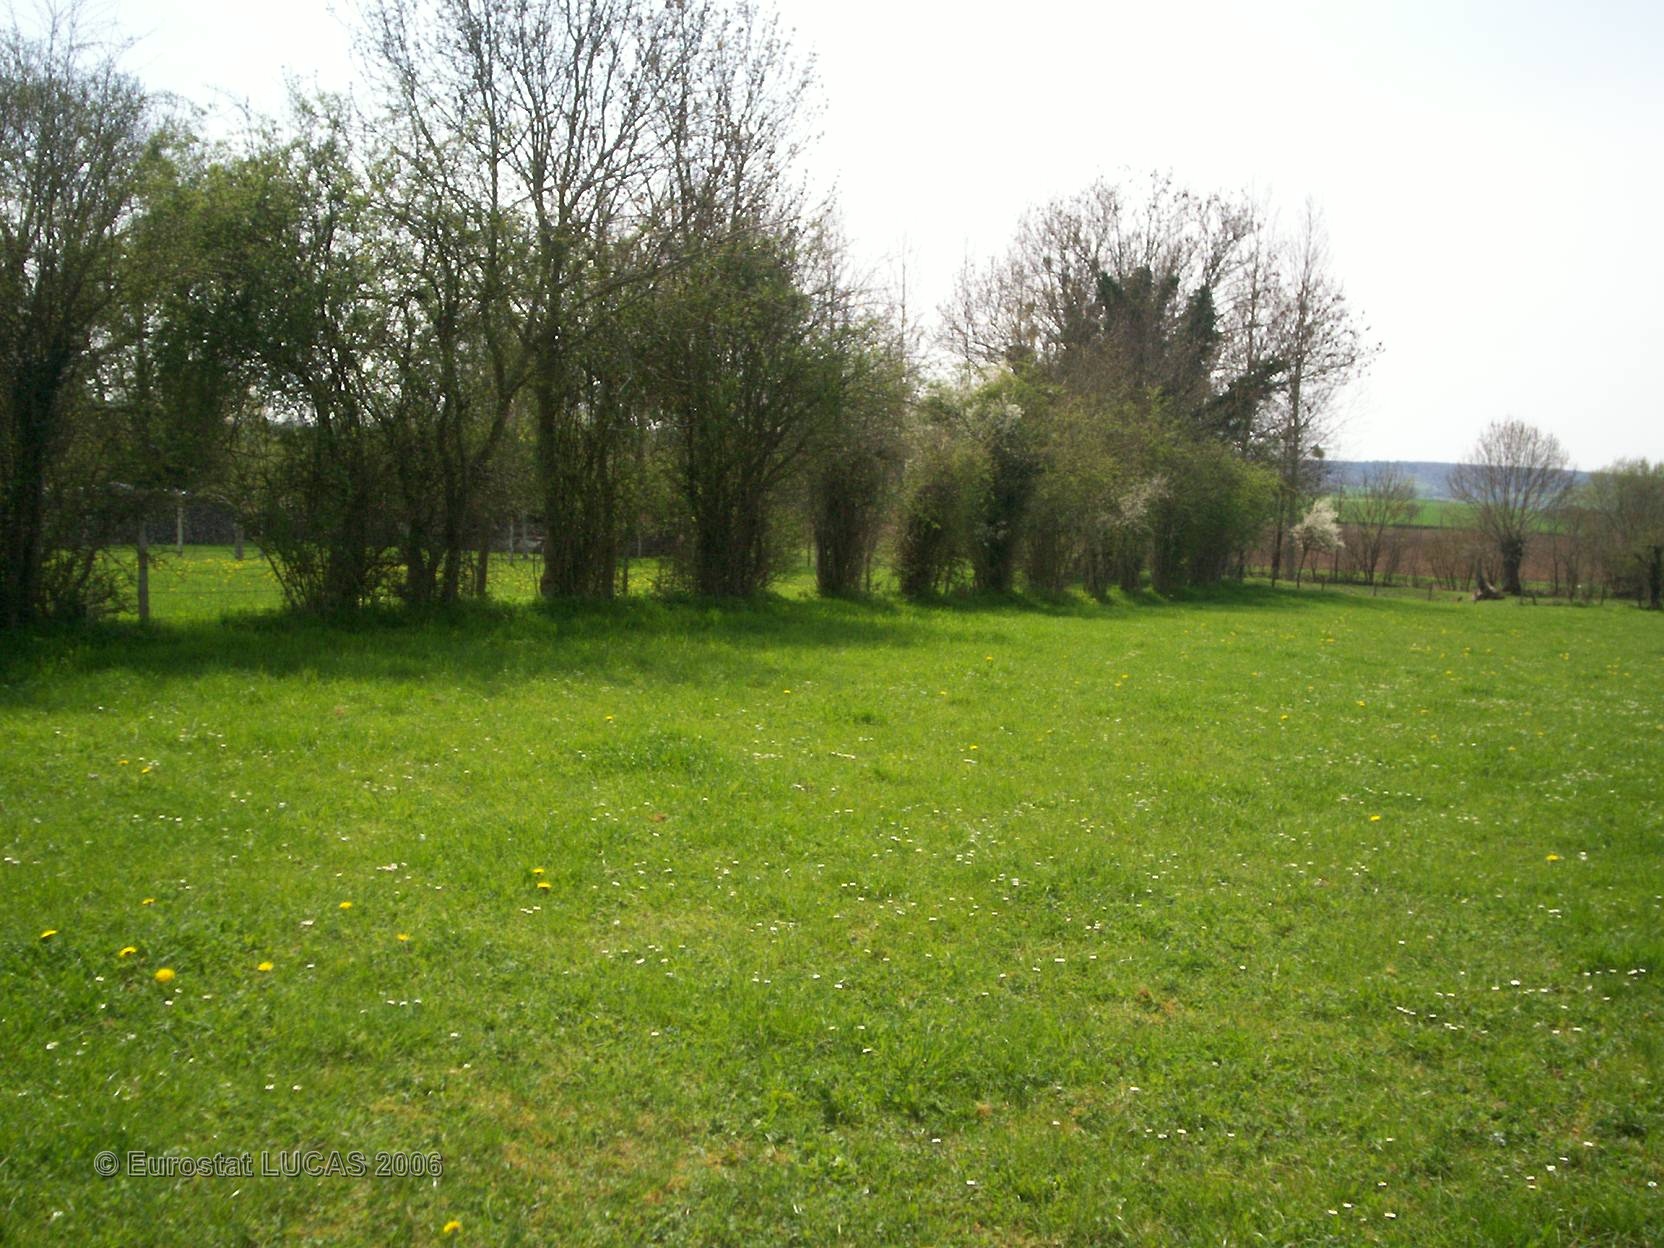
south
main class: Grassland
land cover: Grassland without tree/shrub cover
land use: Agriculture (excluding fallow land and kitchen gardens)
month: April
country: FR
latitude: 48.8099
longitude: 0.0983
